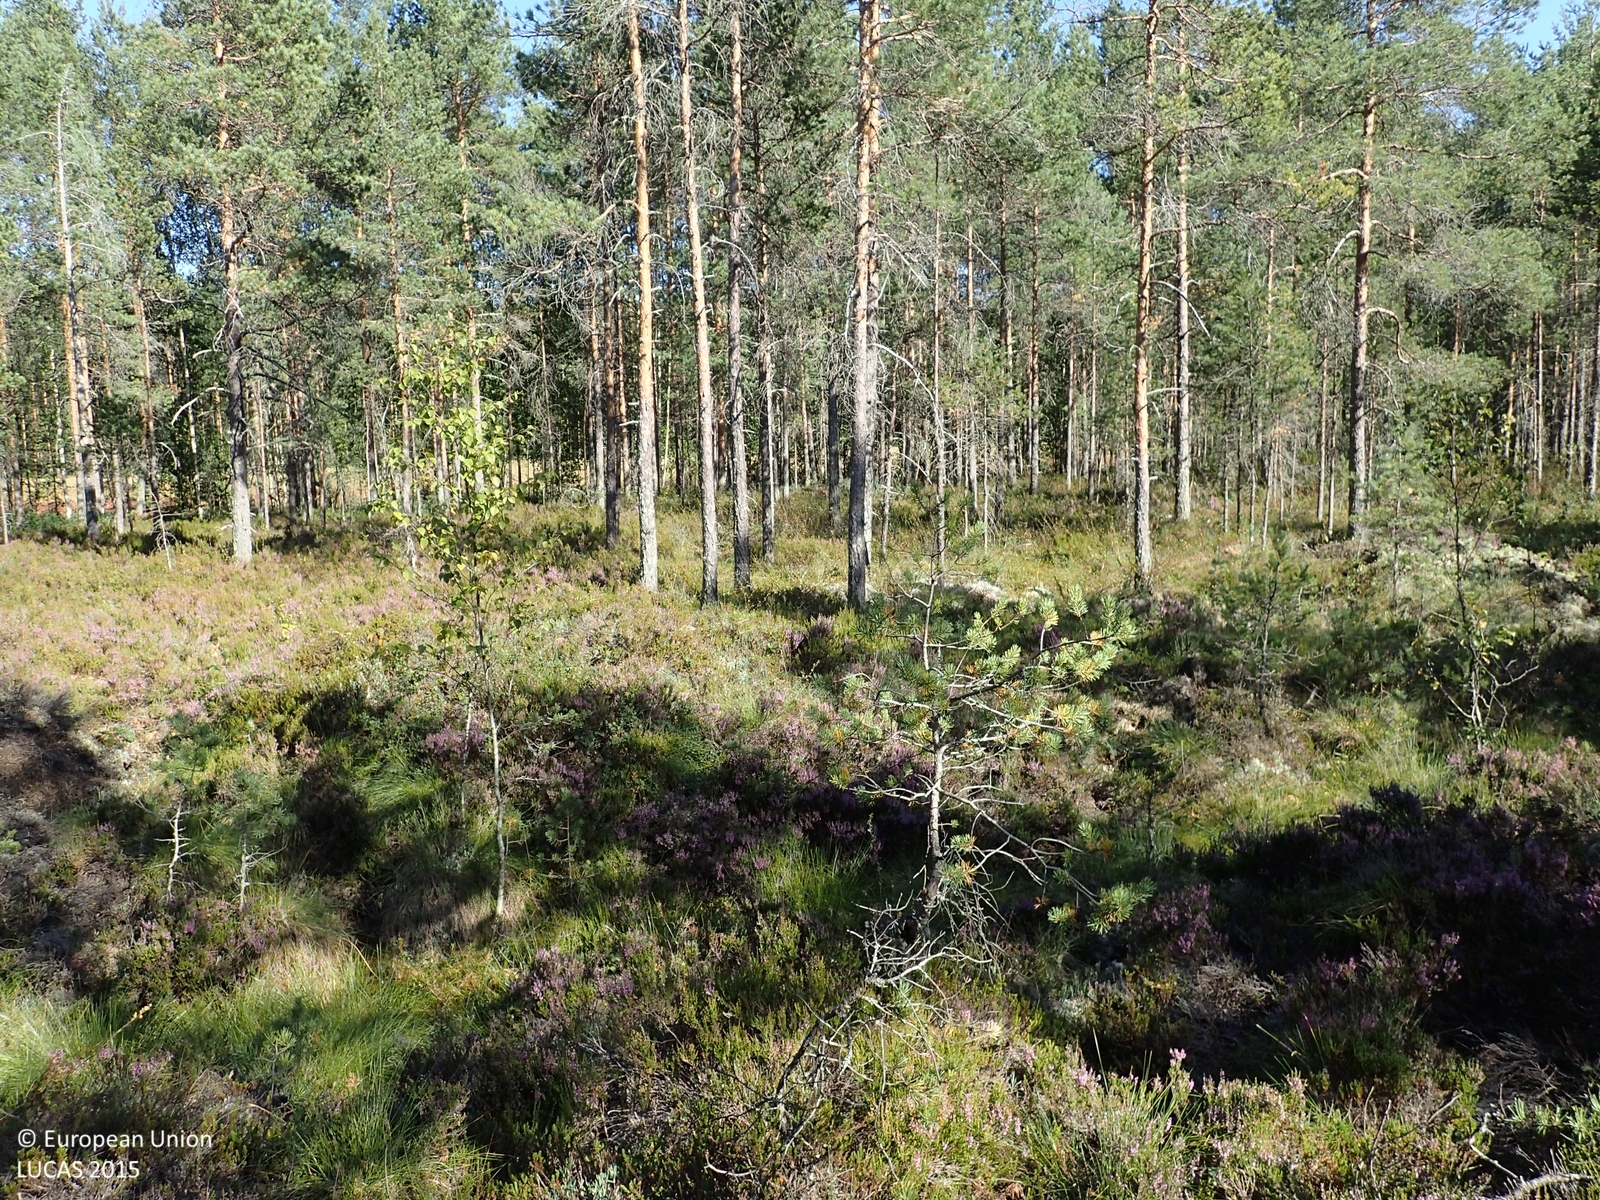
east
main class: Woodland
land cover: Pine dominated coniferous woodland
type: boreal forest
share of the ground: 25 - 50 %
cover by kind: shrubs 55 %, coniferous forest trees 45 %
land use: Forestry
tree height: < 5 m
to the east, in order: Pine dominated coniferous woodland; Ditches and canals; Pine dominated coniferous woodland; Broadleaved woodland; Ditches and canals; Shruby margins; Spontaneously vegetated surfaces; Ditches and canals; Spontaneously vegetated surfaces; Ditches and canals; Spontaneously vegetated surfaces; Ditches and canals; Spontaneously vegetated surfaces; Ditches and canals; Other mixed woodland; Ditches and canals; Spruce dominated mixed woodland
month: August
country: FI
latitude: 62.6206
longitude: 22.7075
